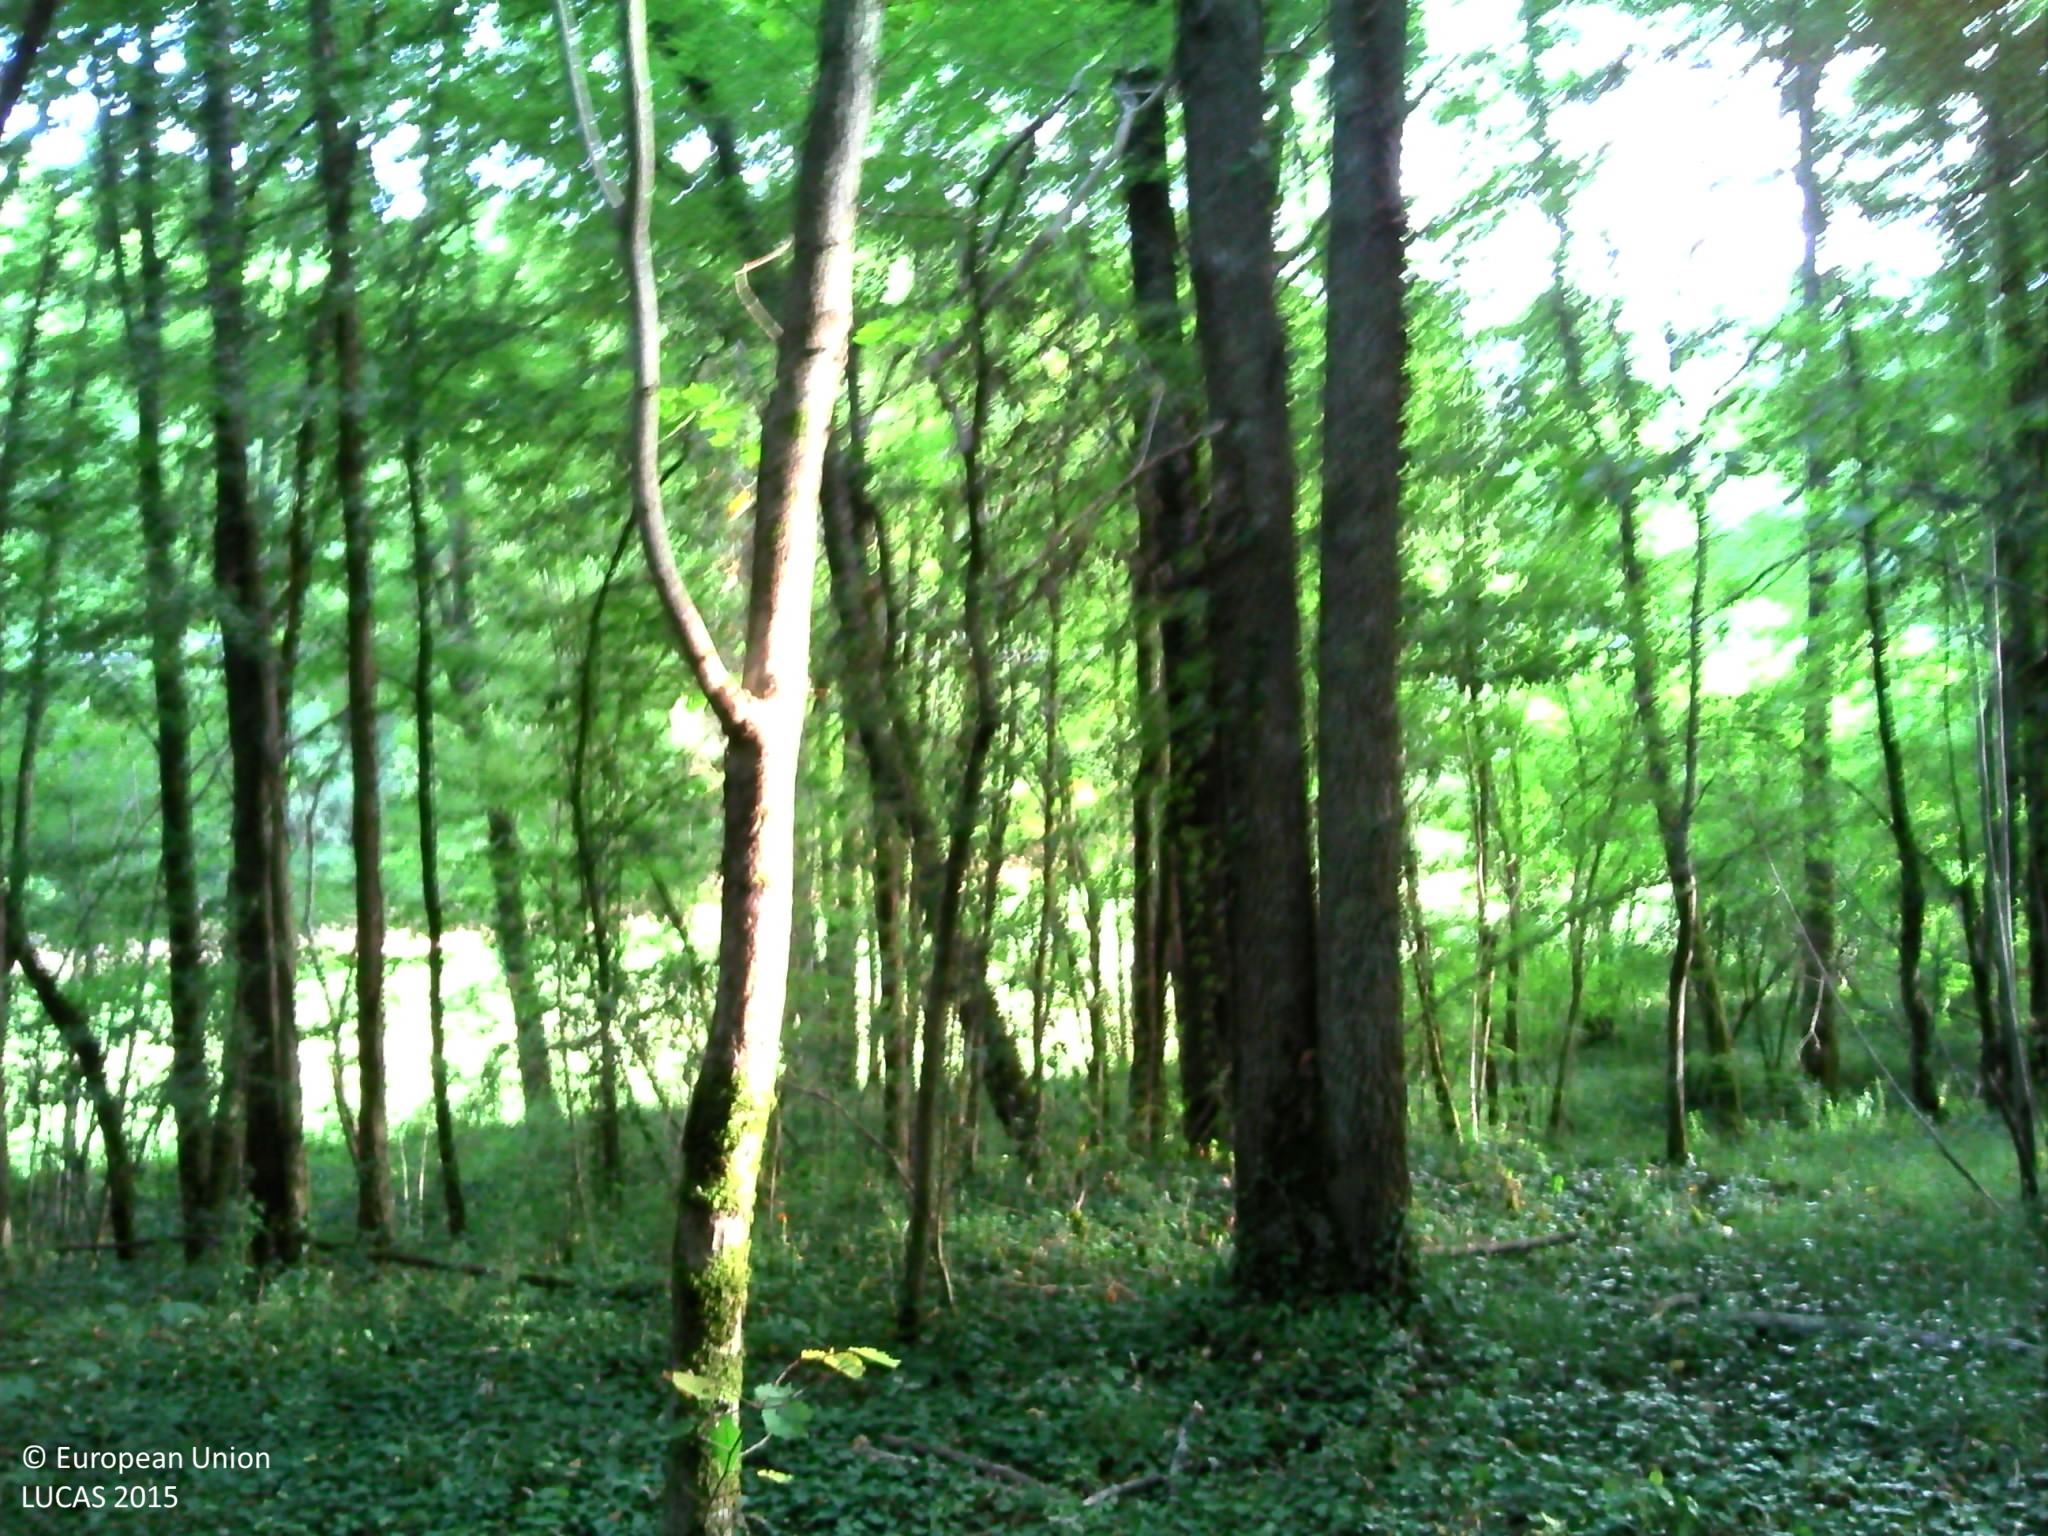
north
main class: Woodland
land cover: Broadleaved woodland
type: acidophilous oak and oak-birch forest
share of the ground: > 75 %
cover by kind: broadleaved forest trees 75 %, herbaceous plants 20 %, shrubs 5 %
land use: Forestry
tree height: > 5 m
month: July
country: FR
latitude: 44.8608
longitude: 0.9447
